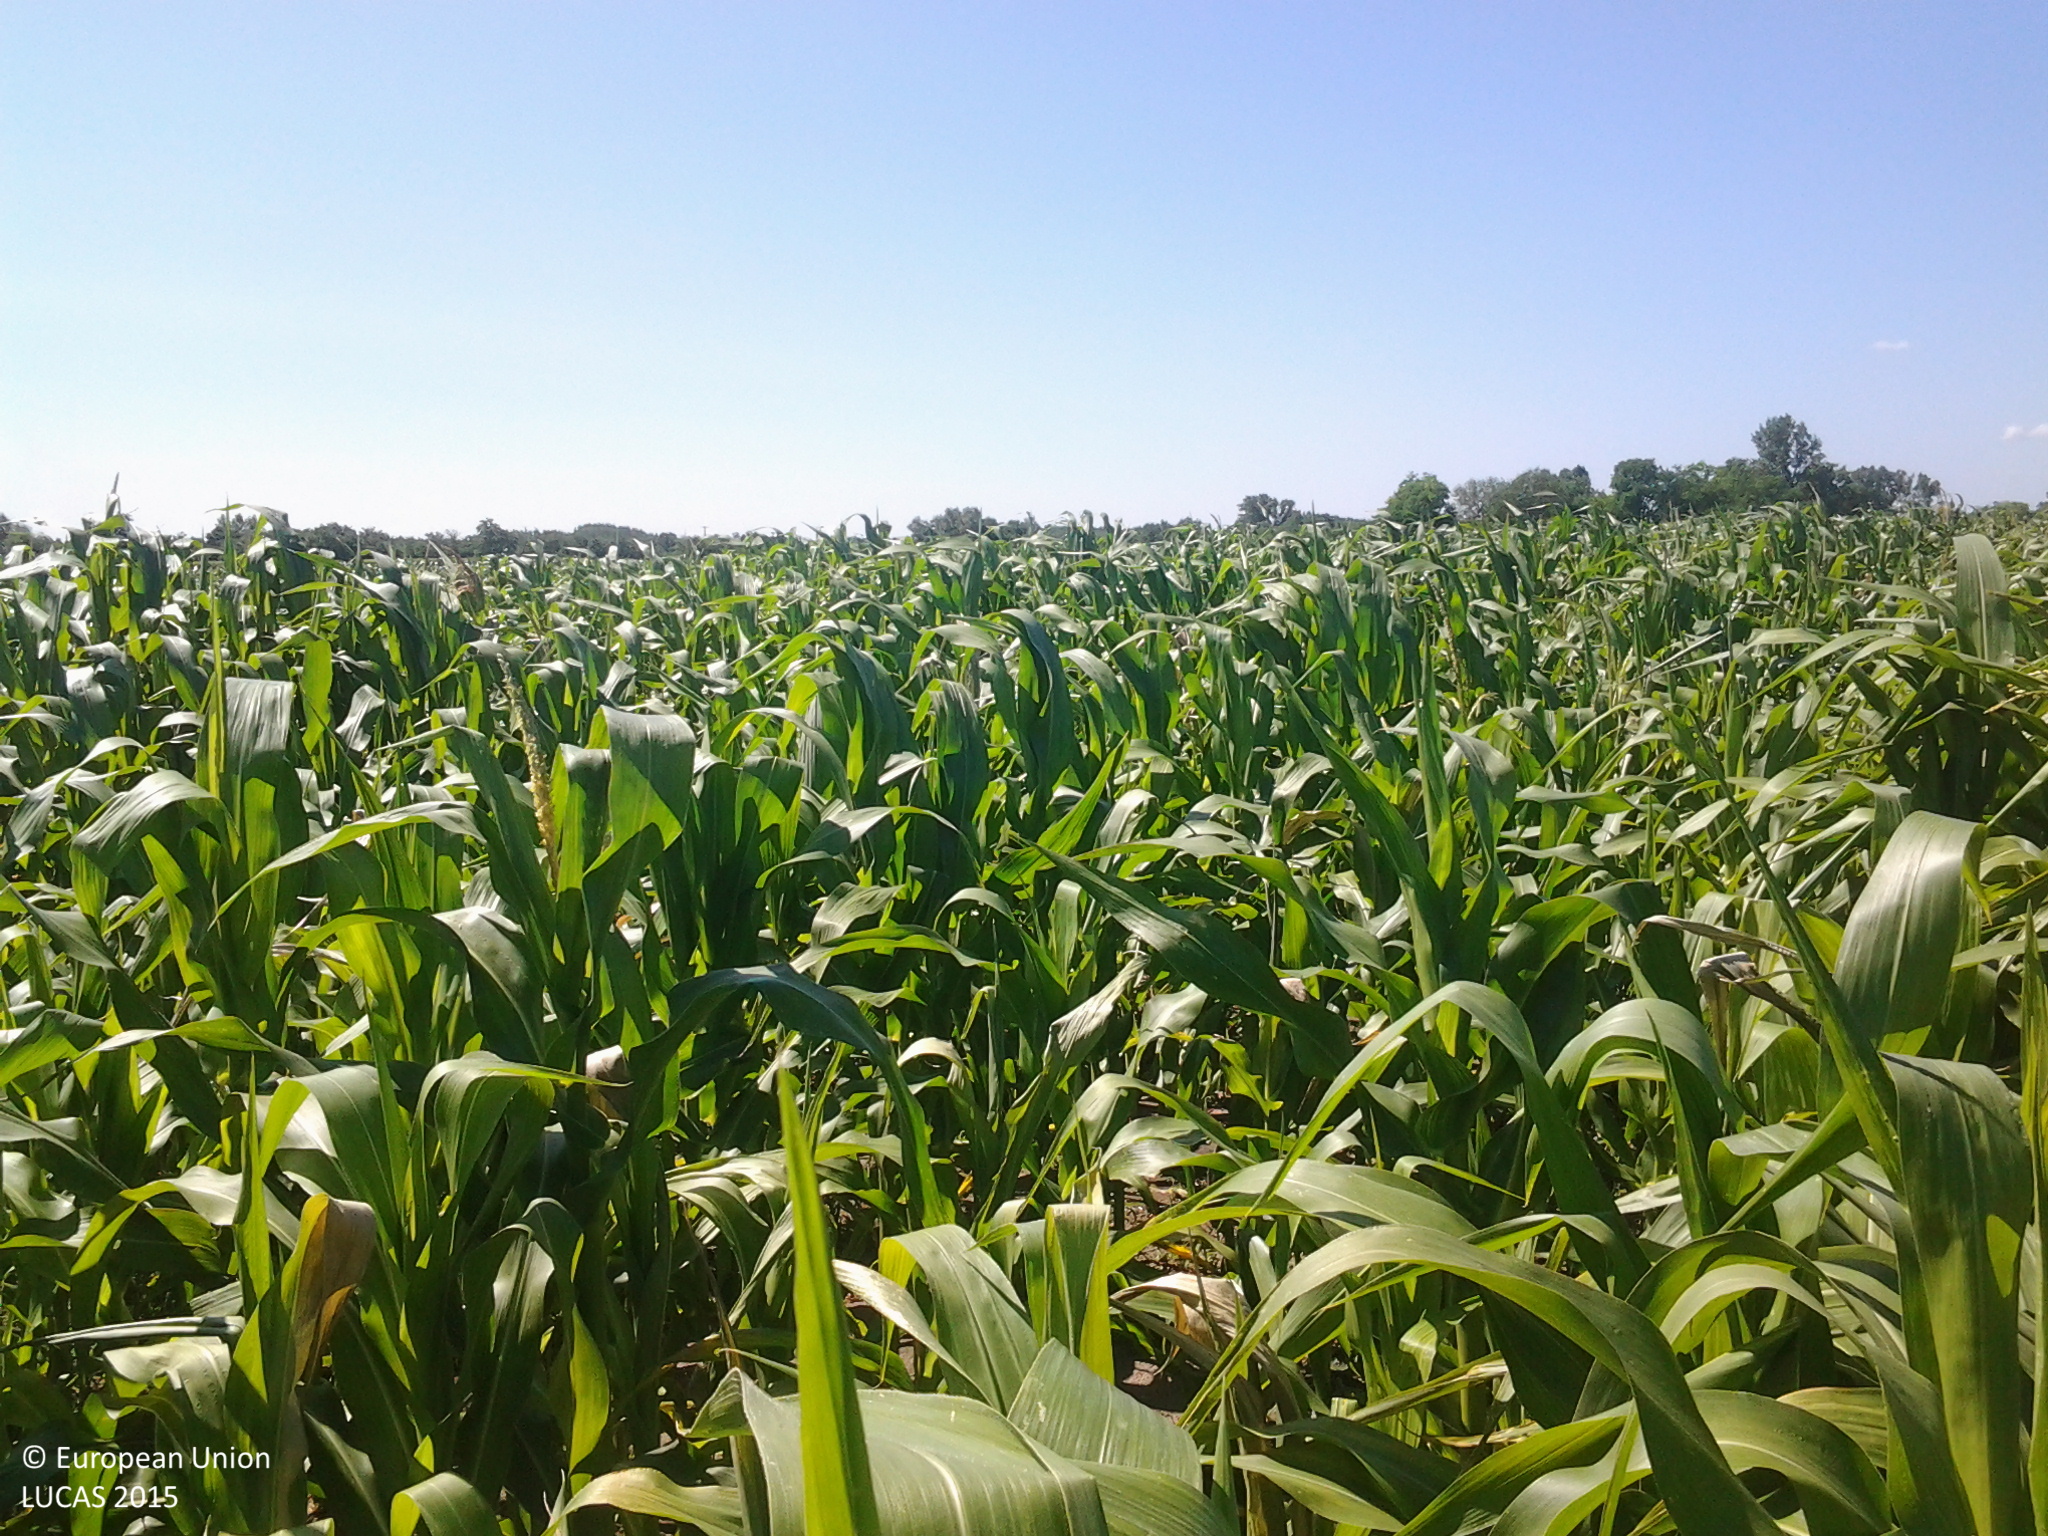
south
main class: Cropland
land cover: Maize
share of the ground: > 75 %
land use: Agriculture (excluding fallow land and kitchen gardens)
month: July
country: HU
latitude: 46.5596
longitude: 19.5273
